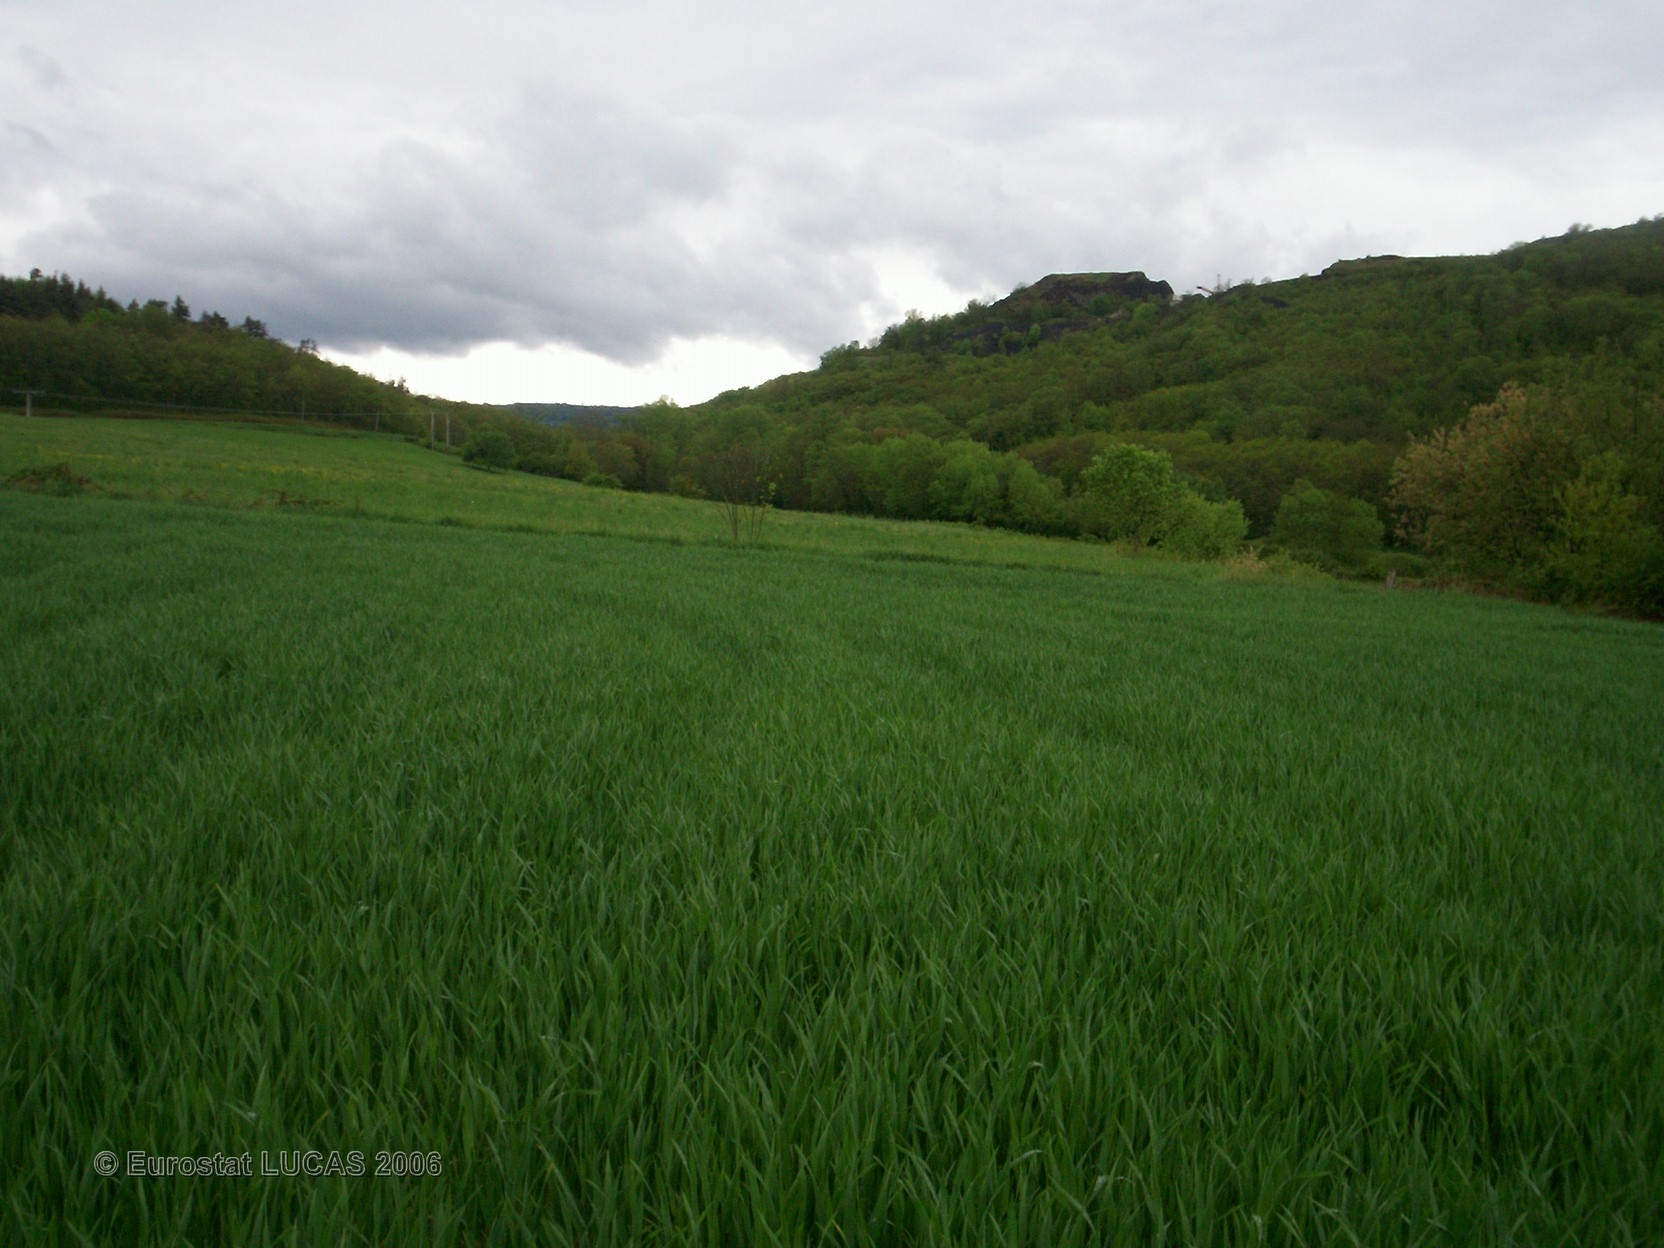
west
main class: Cropland
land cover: Common wheat
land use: Agriculture (excluding fallow land and kitchen gardens)
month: May
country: FR
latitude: 45.4143
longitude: 3.2417
